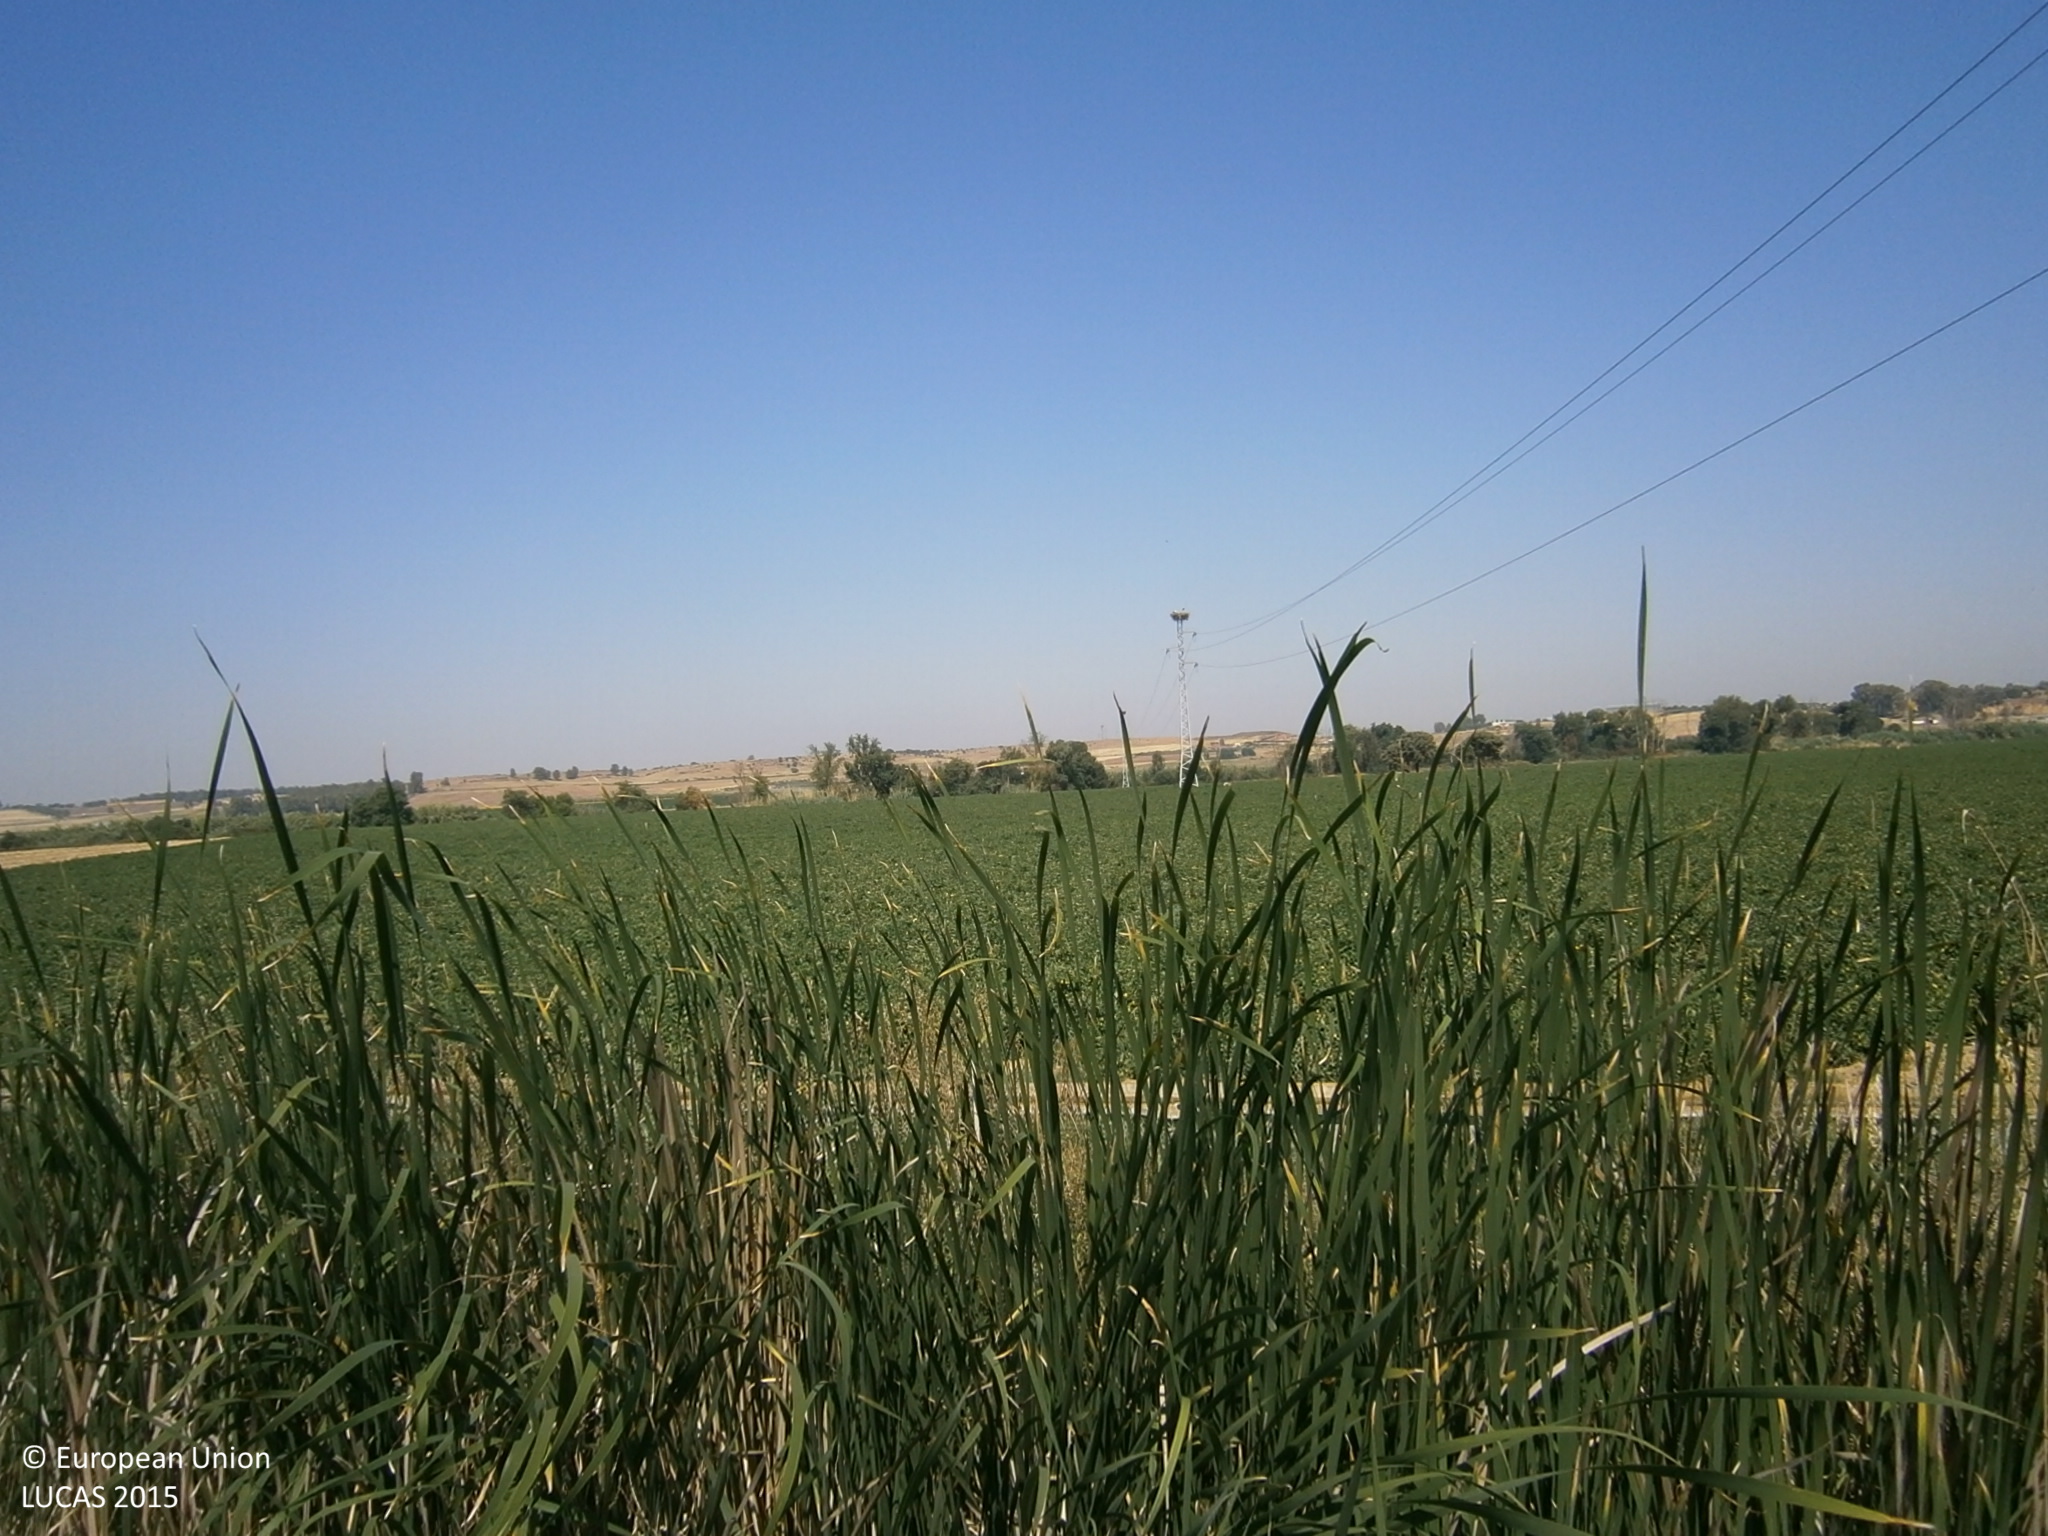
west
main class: Cropland
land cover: Tomatoes
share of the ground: > 75 %
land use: Agriculture (excluding fallow land and kitchen gardens)
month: June
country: ES
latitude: 38.8507
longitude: -6.7610
